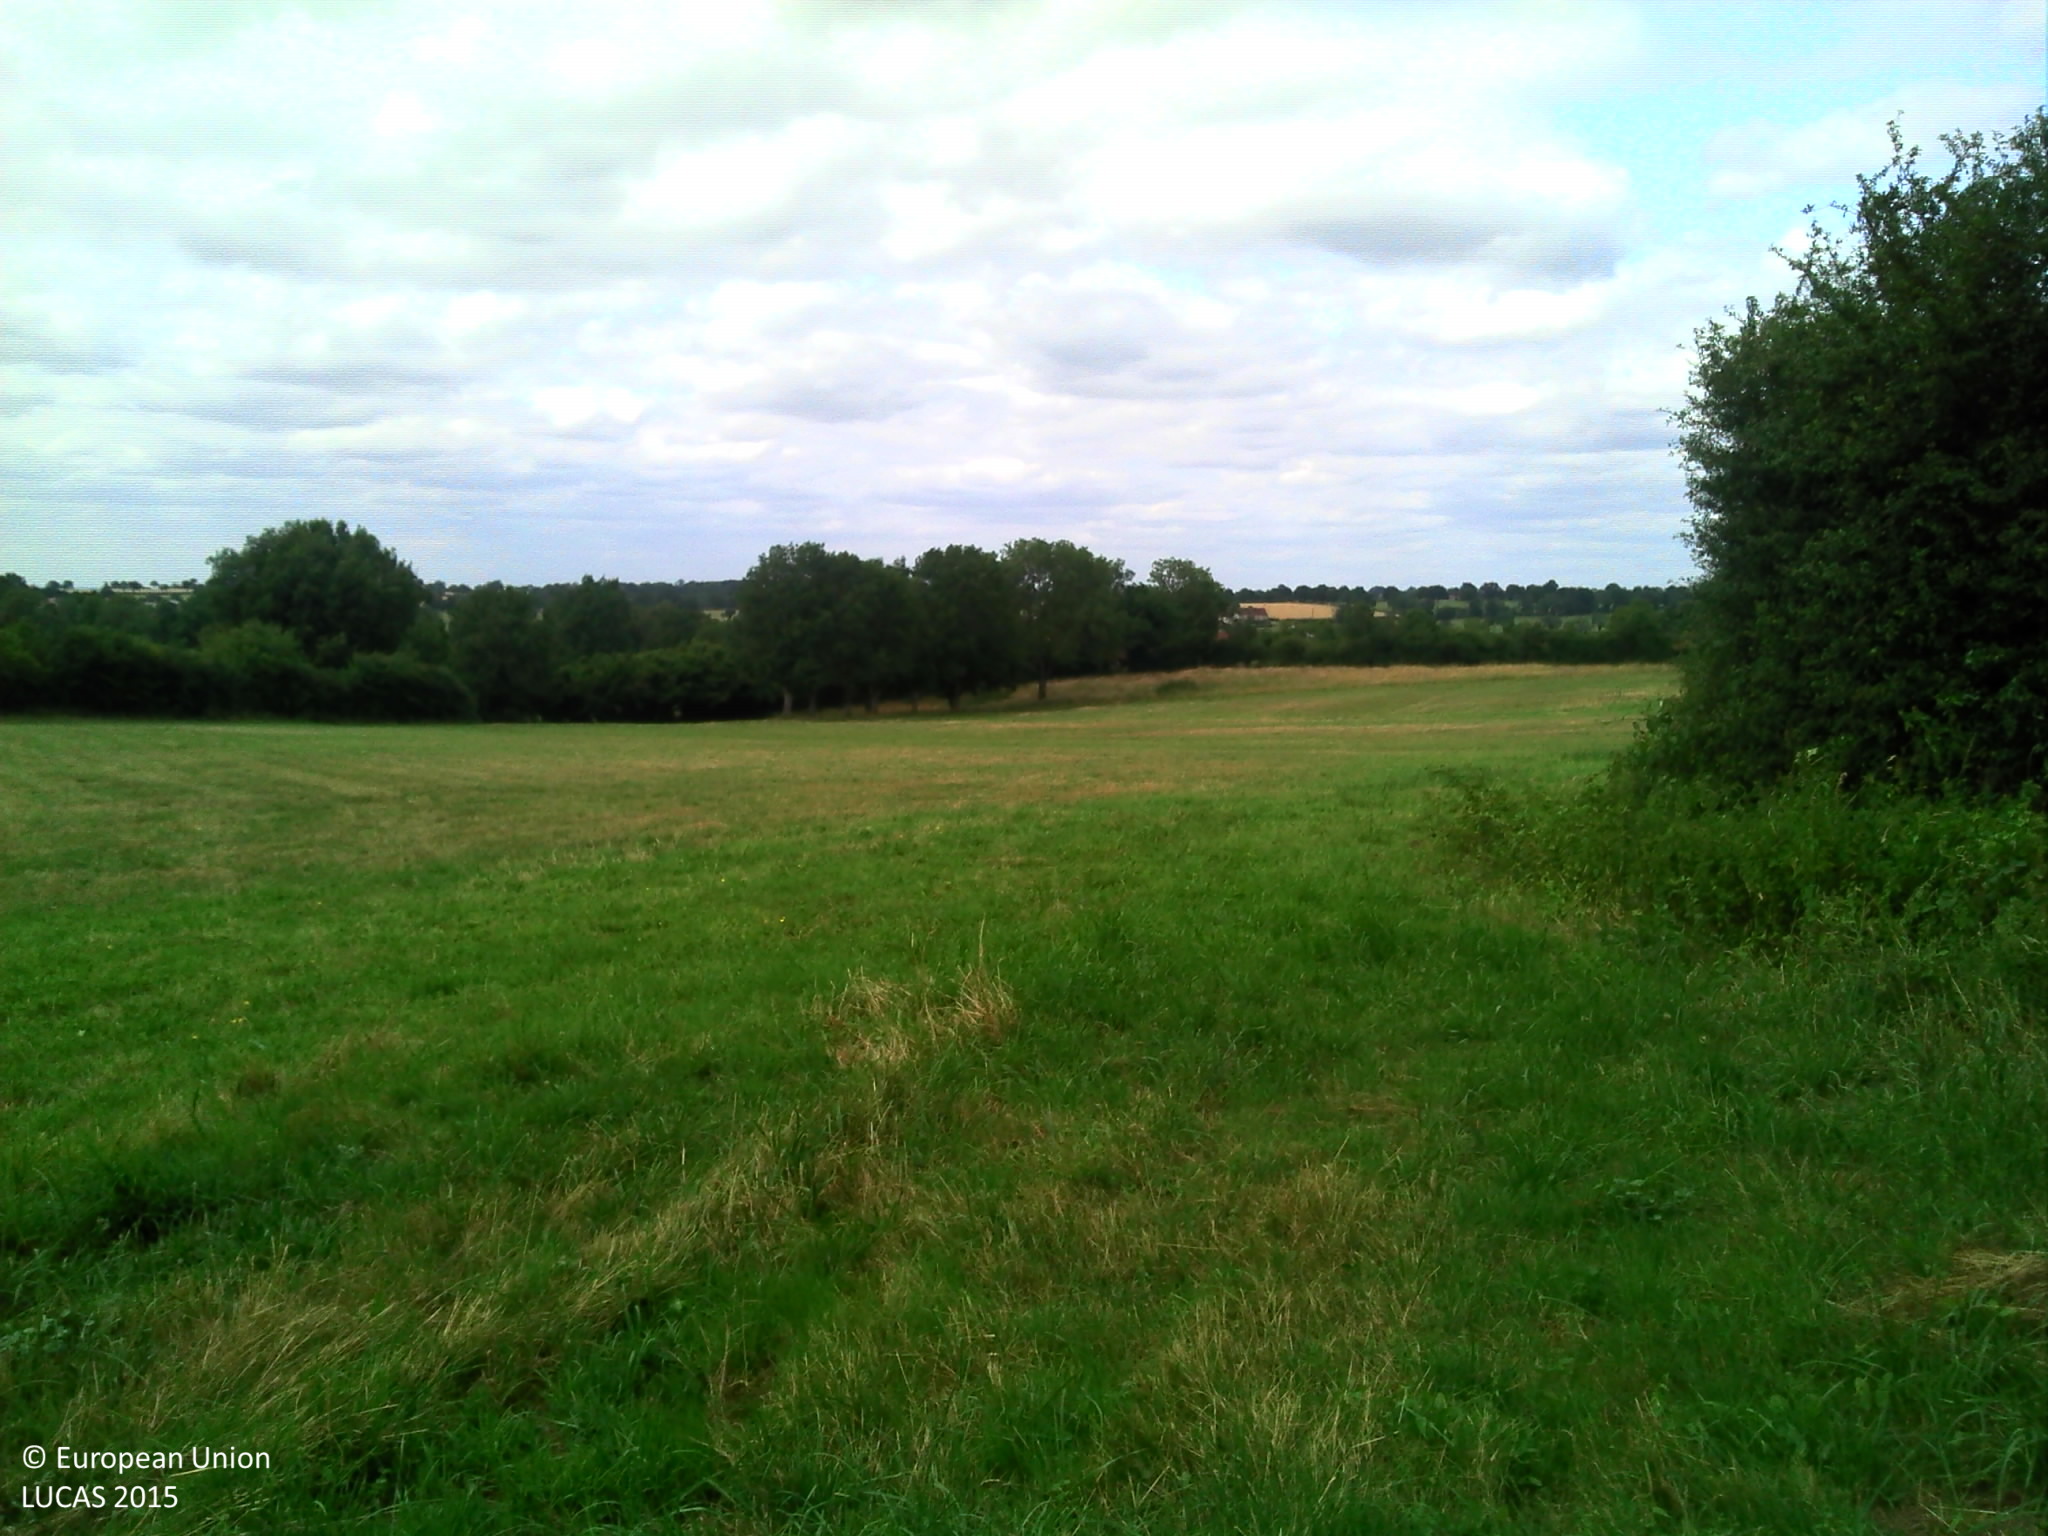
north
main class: Grassland
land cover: Grassland without tree/shrub cover
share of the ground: > 75 %
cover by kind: herbaceous plants 100 %
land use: Agriculture (excluding fallow land and kitchen gardens)
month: July
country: FR
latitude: 46.4492
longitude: 3.0327
